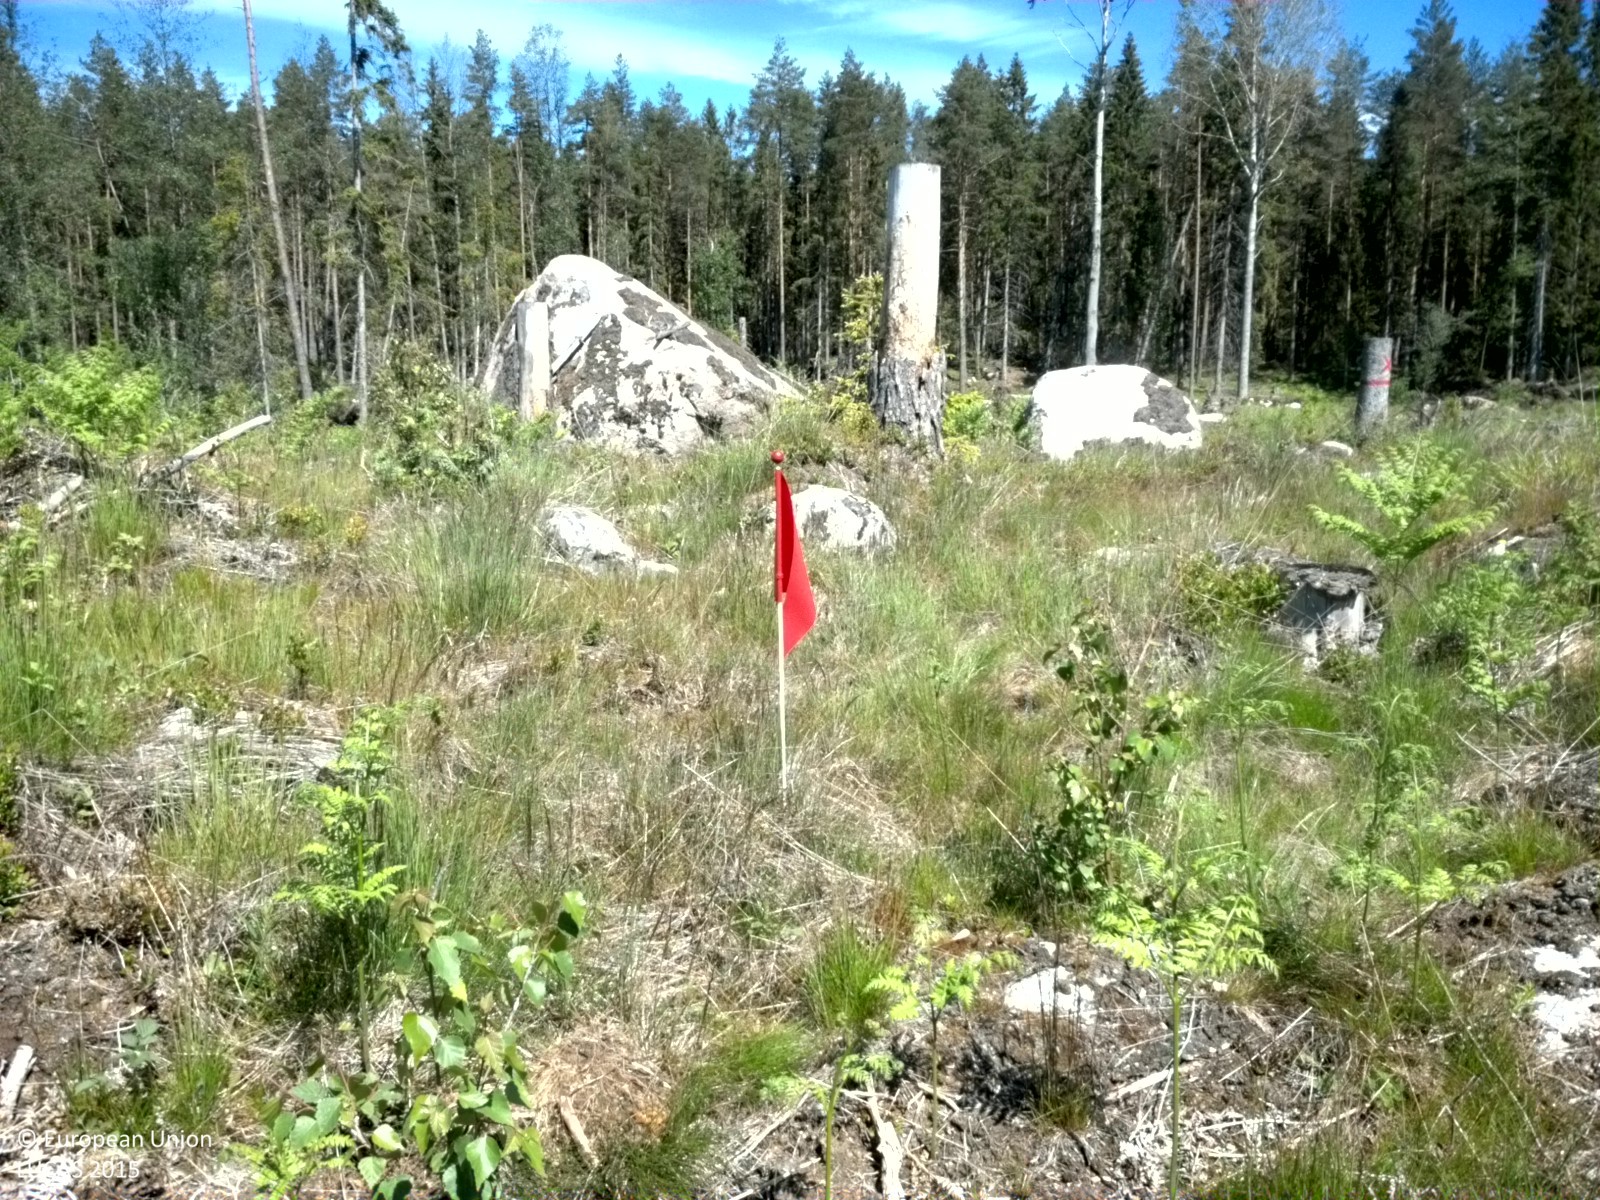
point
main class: Grassland
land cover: Grassland with sparse tree/shrub cover
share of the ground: > 75 %
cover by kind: herbaceous plants 65 %, shrubs 10 %, consolidated bare surface 10 %, broadleaved forest trees 5 %
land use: Forestry
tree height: > 5 m
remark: Clear cut
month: June
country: SE
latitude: 60.2472
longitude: 17.5978
